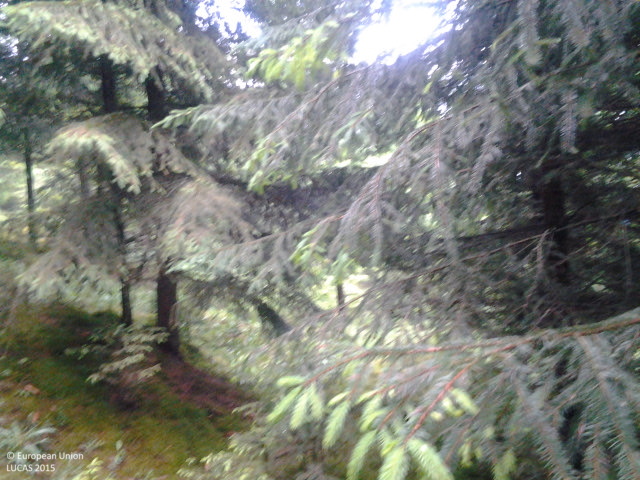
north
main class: Woodland
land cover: Spruce dominated coniferous woodland
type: alpine coniferous forest
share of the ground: > 75 %
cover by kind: coniferous forest trees 100 %
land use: Forestry
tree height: > 5 m
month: June
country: RO
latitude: 47.3034
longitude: 25.3610
